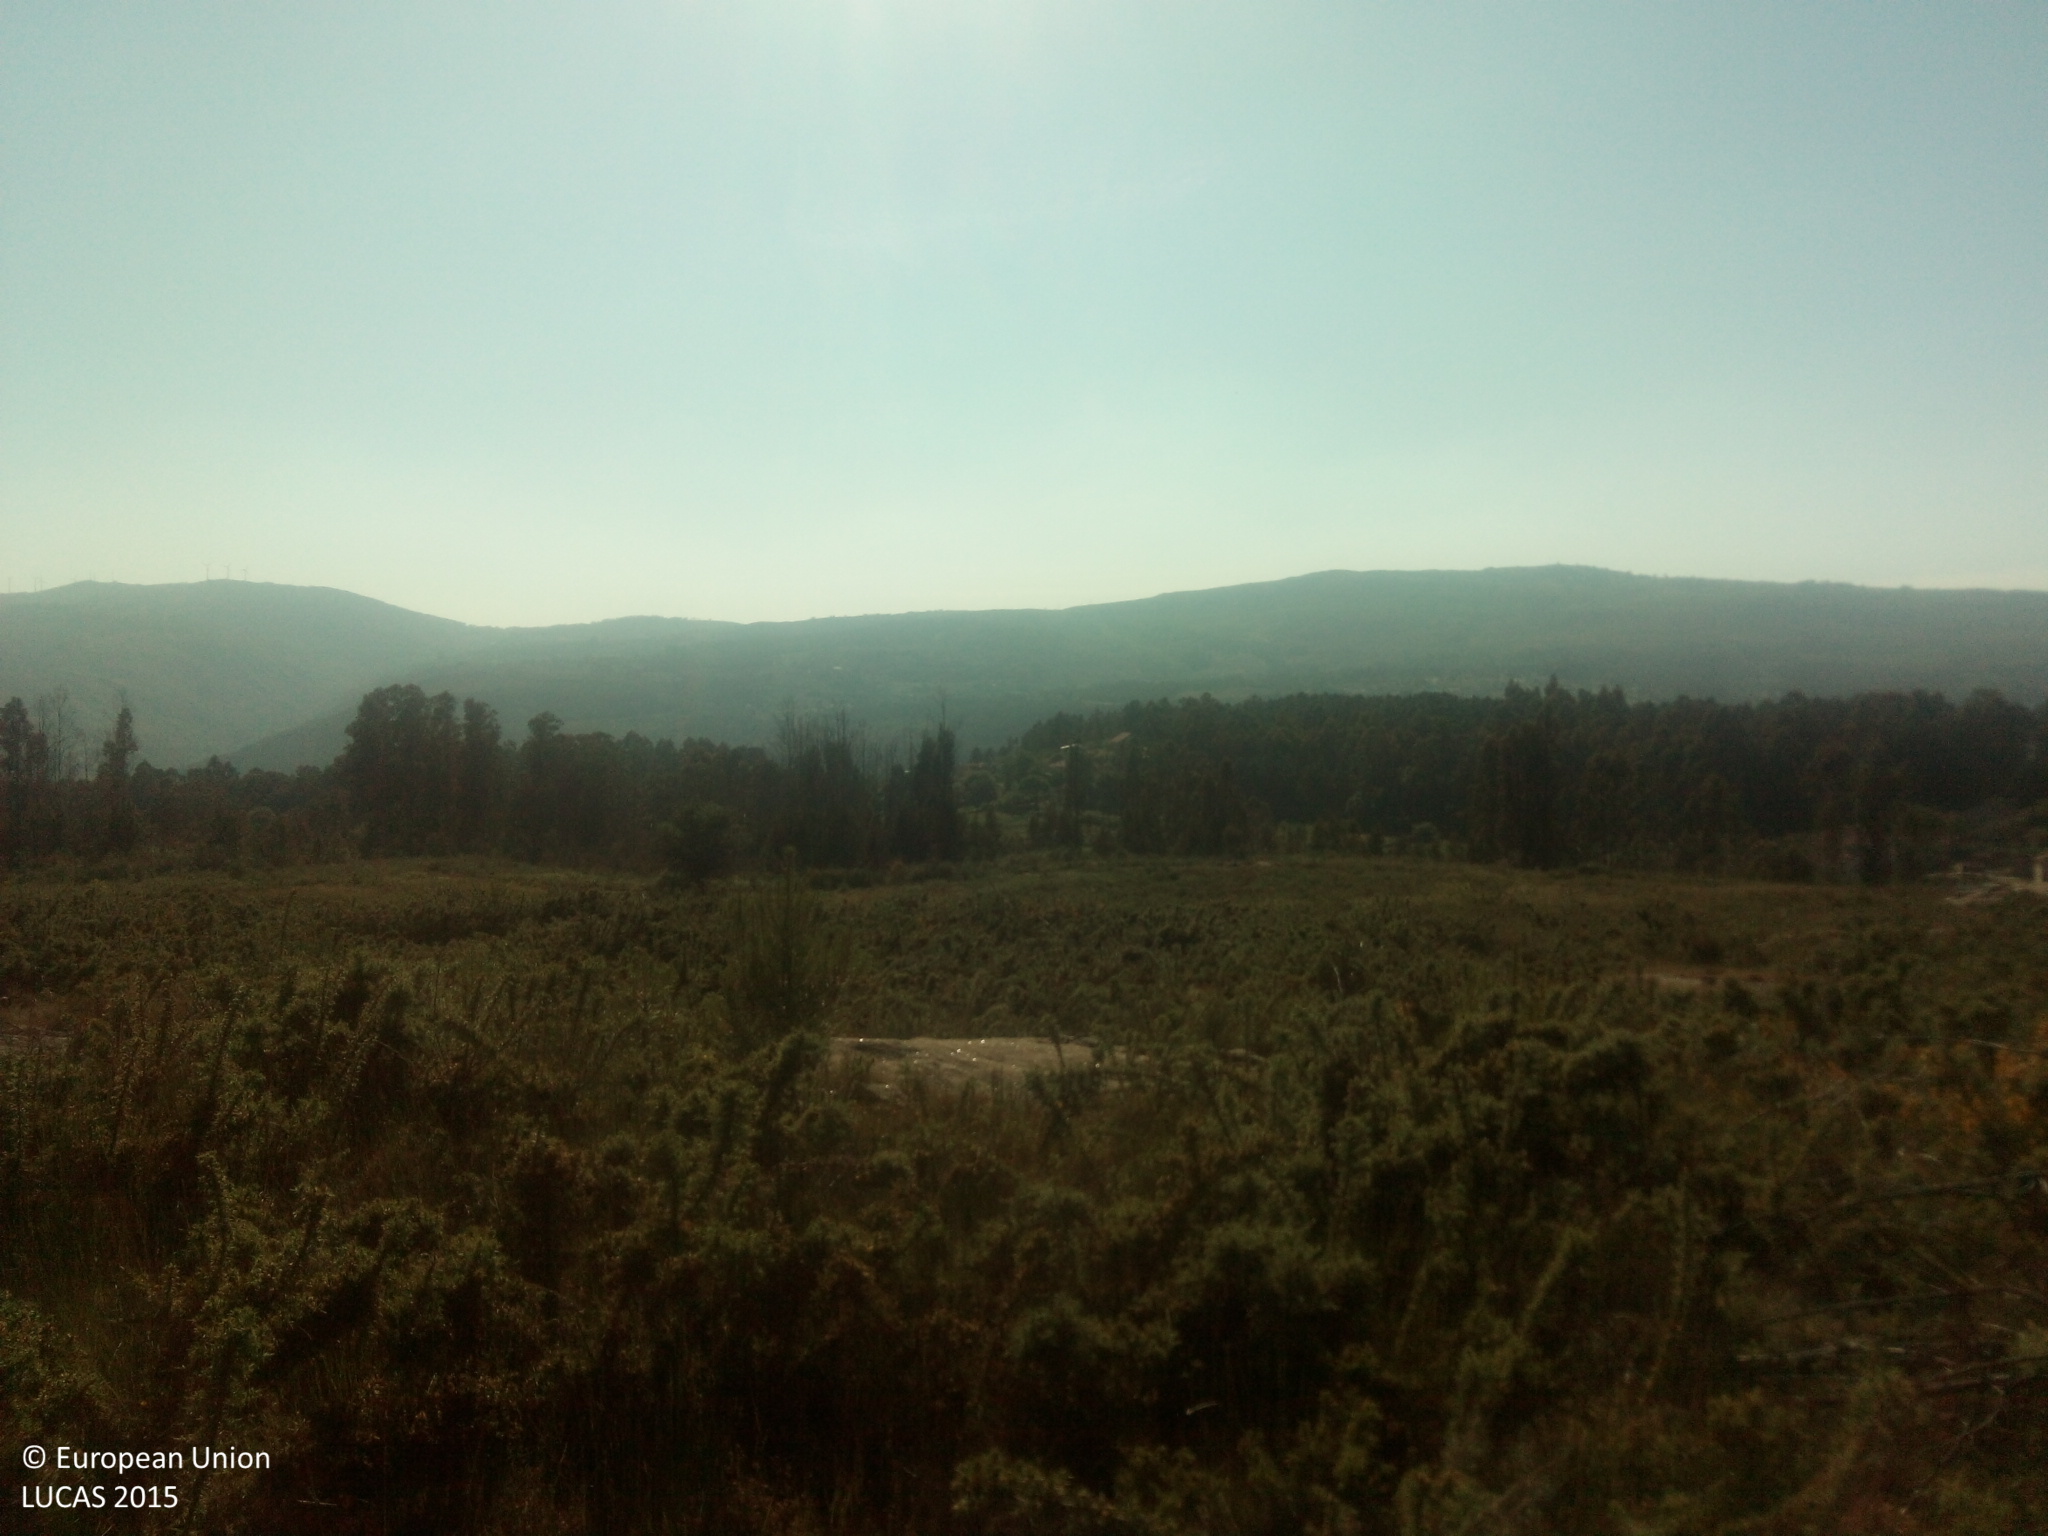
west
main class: Shrubland
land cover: Shrubland without tree cover
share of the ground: > 75 %
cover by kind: shrubs 100 %
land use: Semi-natural and natural areas not in use
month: June
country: ES
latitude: 42.1956
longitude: -8.2637
